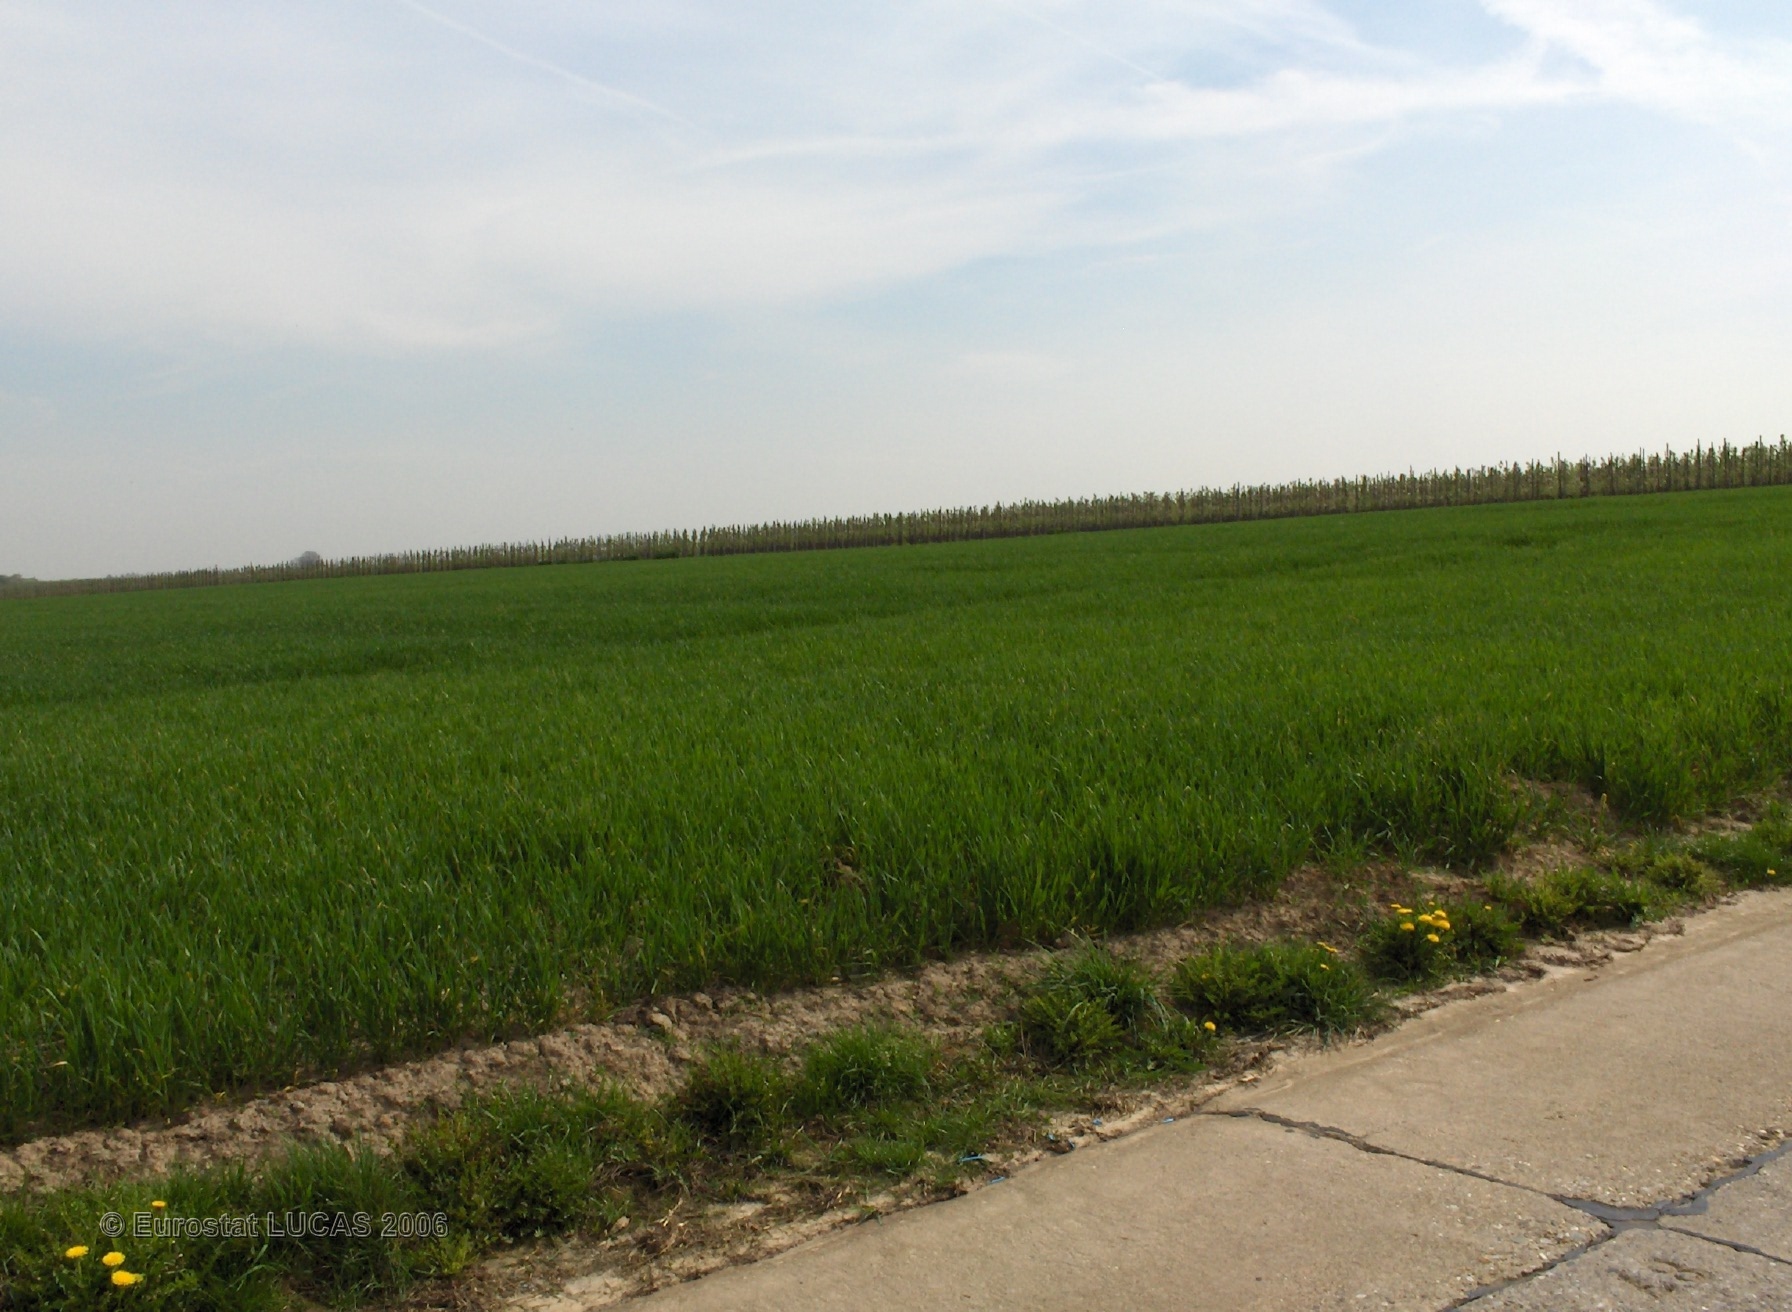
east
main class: Cropland
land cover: Dry pulses
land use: Agriculture (excluding fallow land and kitchen gardens)
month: May
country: BE
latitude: 50.7506
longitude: 5.2211
